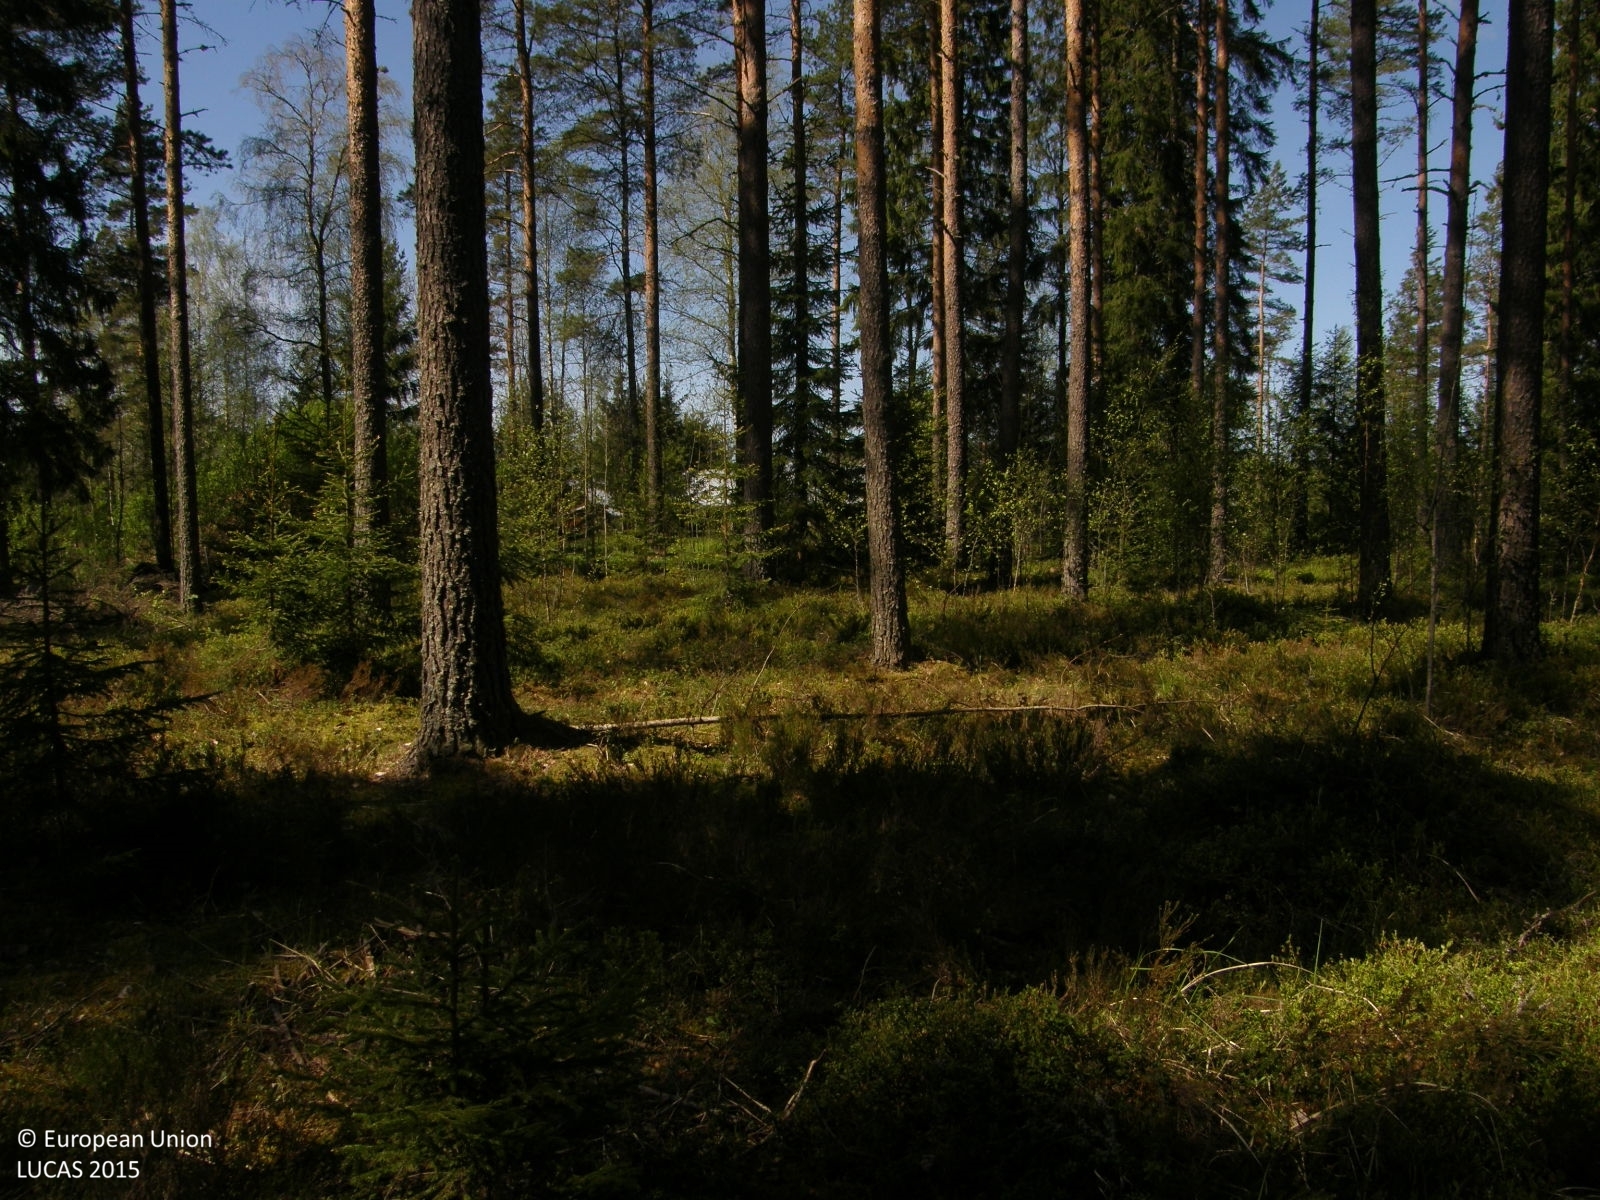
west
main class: Woodland
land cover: Pine dominated coniferous woodland
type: boreal forest
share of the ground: 50 - 75 %
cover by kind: coniferous forest trees 70 %, shrubs 30 %
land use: Forestry
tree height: > 5 m
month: June
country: FI
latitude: 62.1444
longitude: 22.2761
